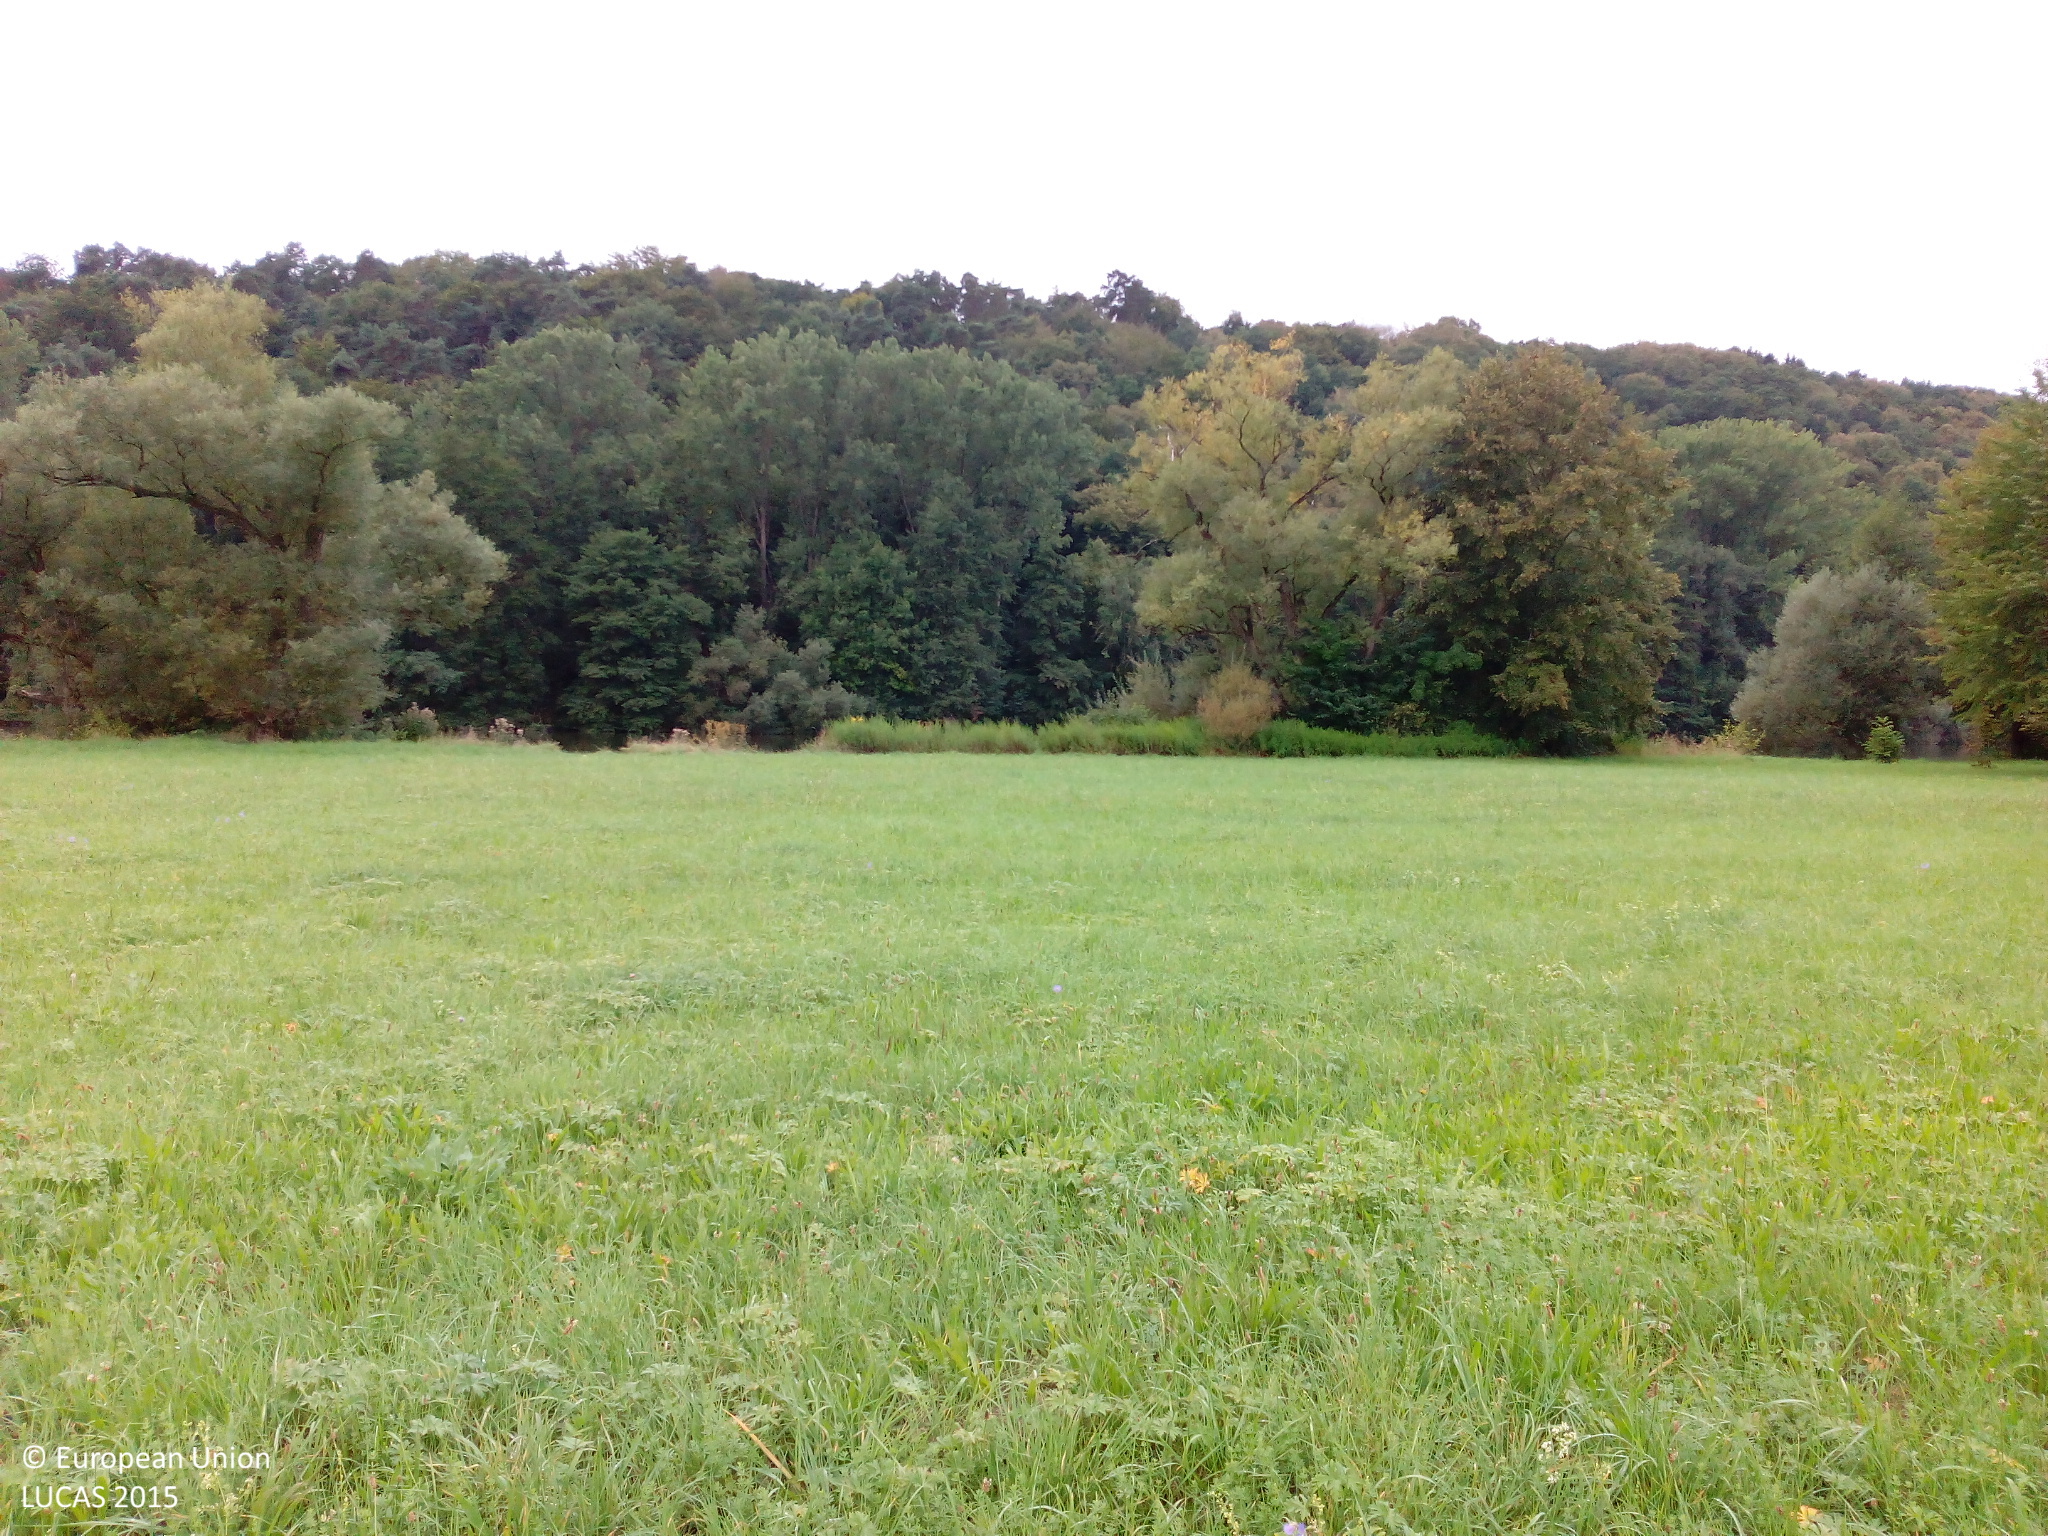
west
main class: Grassland
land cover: Grassland without tree/shrub cover
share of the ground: > 75 %
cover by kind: herbaceous plants 100 %
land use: Agriculture (excluding fallow land and kitchen gardens)
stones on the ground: < 10 %
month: September
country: DE
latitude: 49.7518
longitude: 9.5699
